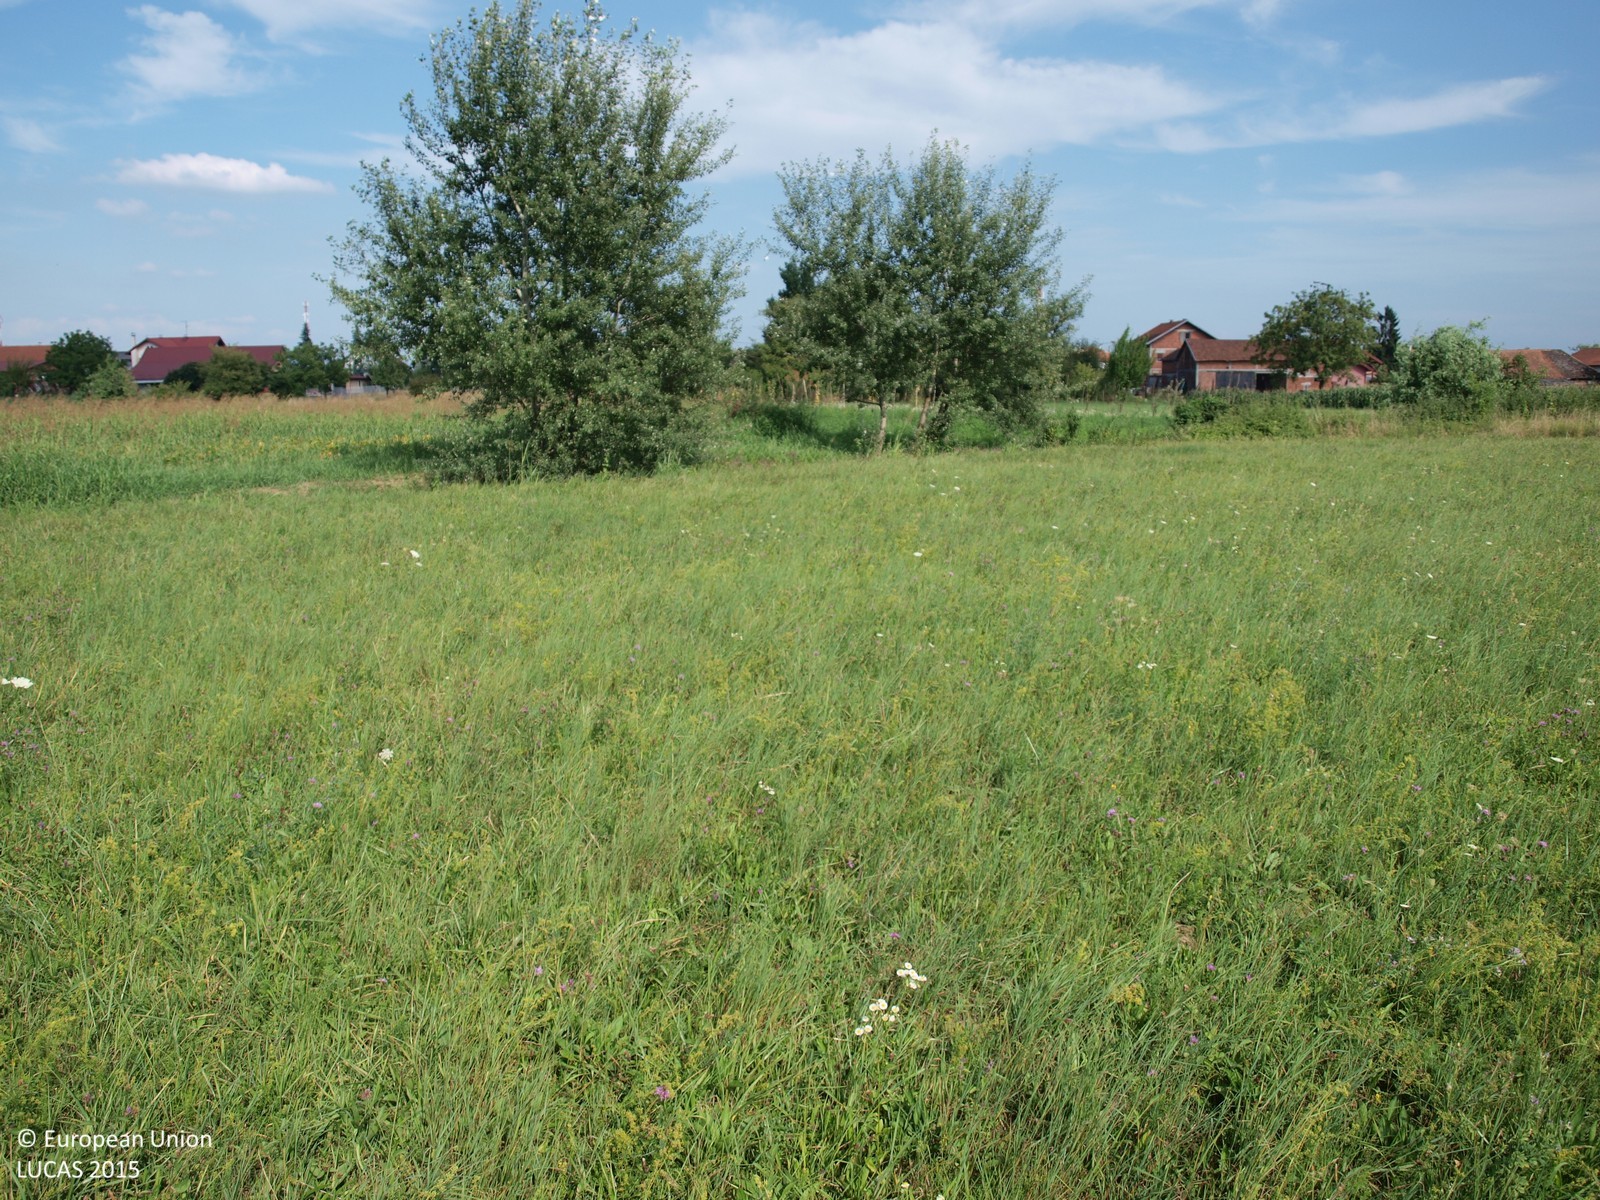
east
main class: Grassland
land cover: Grassland without tree/shrub cover
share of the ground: > 75 %
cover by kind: herbaceous plants 100 %
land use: Agriculture (excluding fallow land and kitchen gardens)
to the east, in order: Grassland without tree/shrub cover; Ditches and canals; Dry pulses; Tomatoes; Other fruit trees and berries; Artificial constructions in urban areas
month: August
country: HR
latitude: 45.8840
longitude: 16.1707
